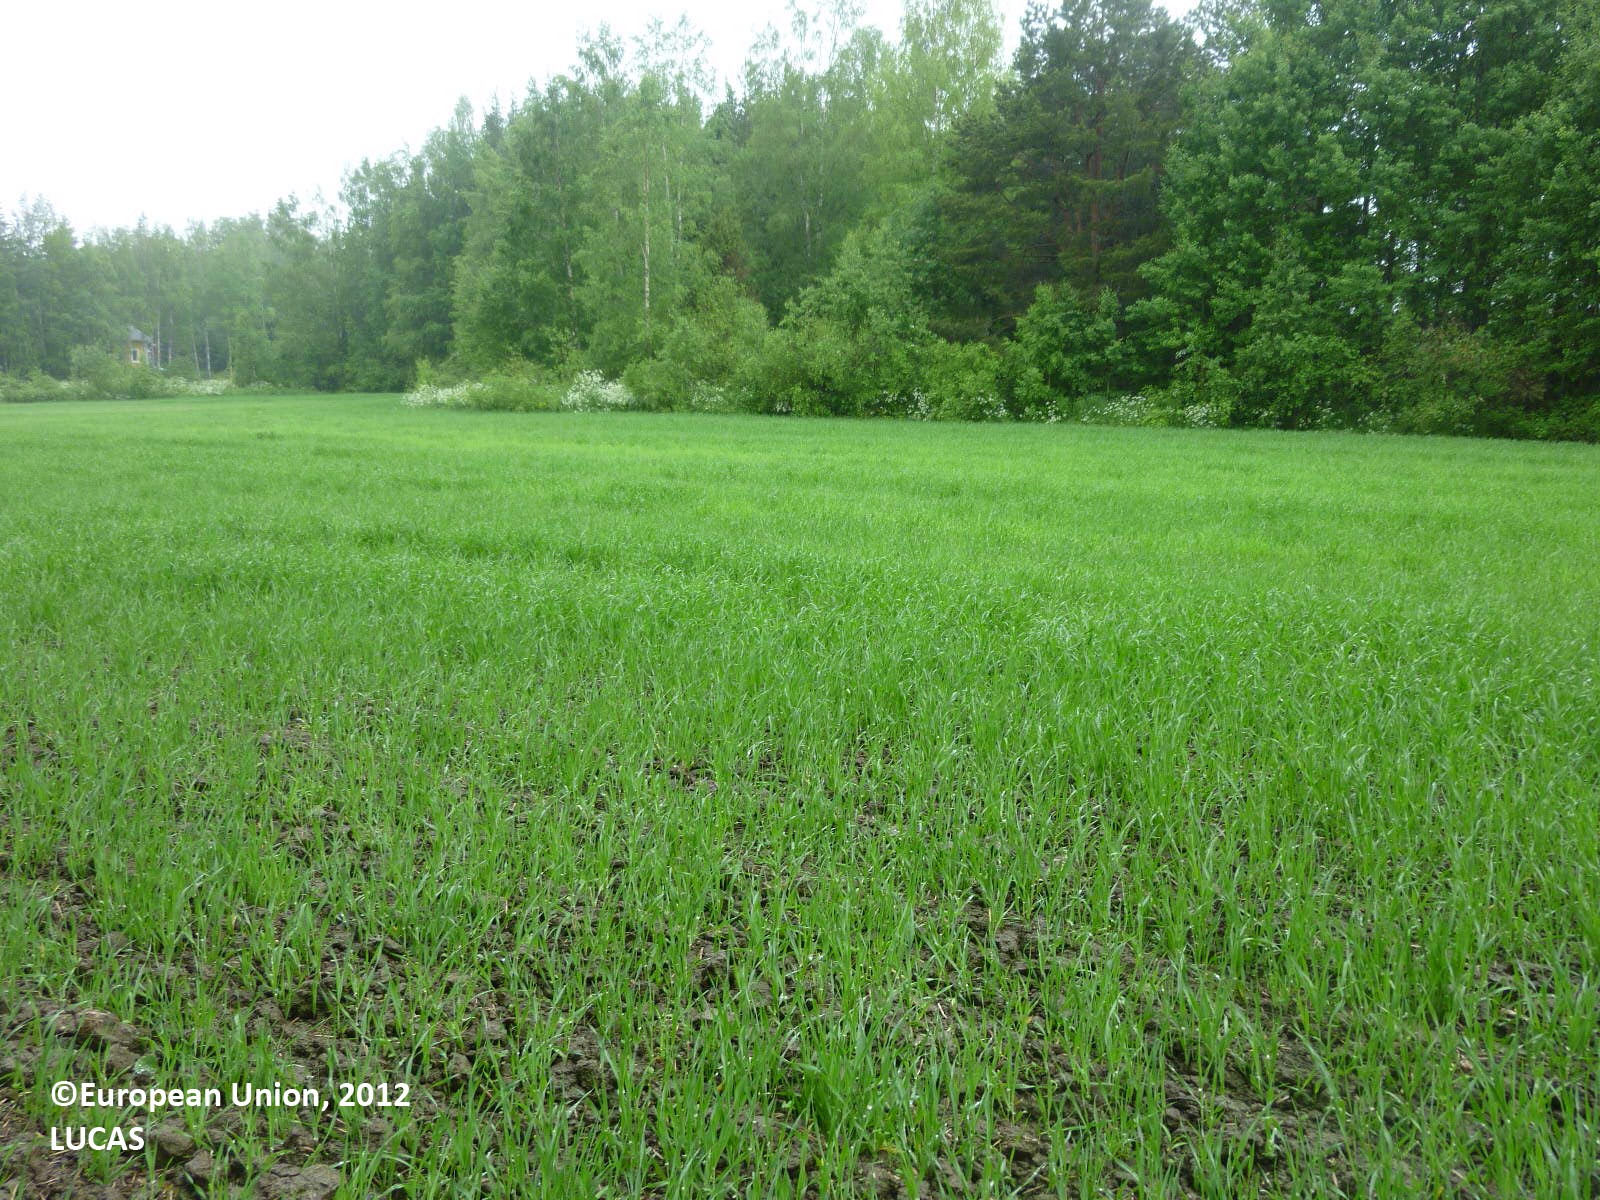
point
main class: Cropland
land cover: Barley
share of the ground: > 75 %
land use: Agriculture (excluding fallow land and kitchen gardens)
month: June
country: FI
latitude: 61.6094
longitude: 22.3335
